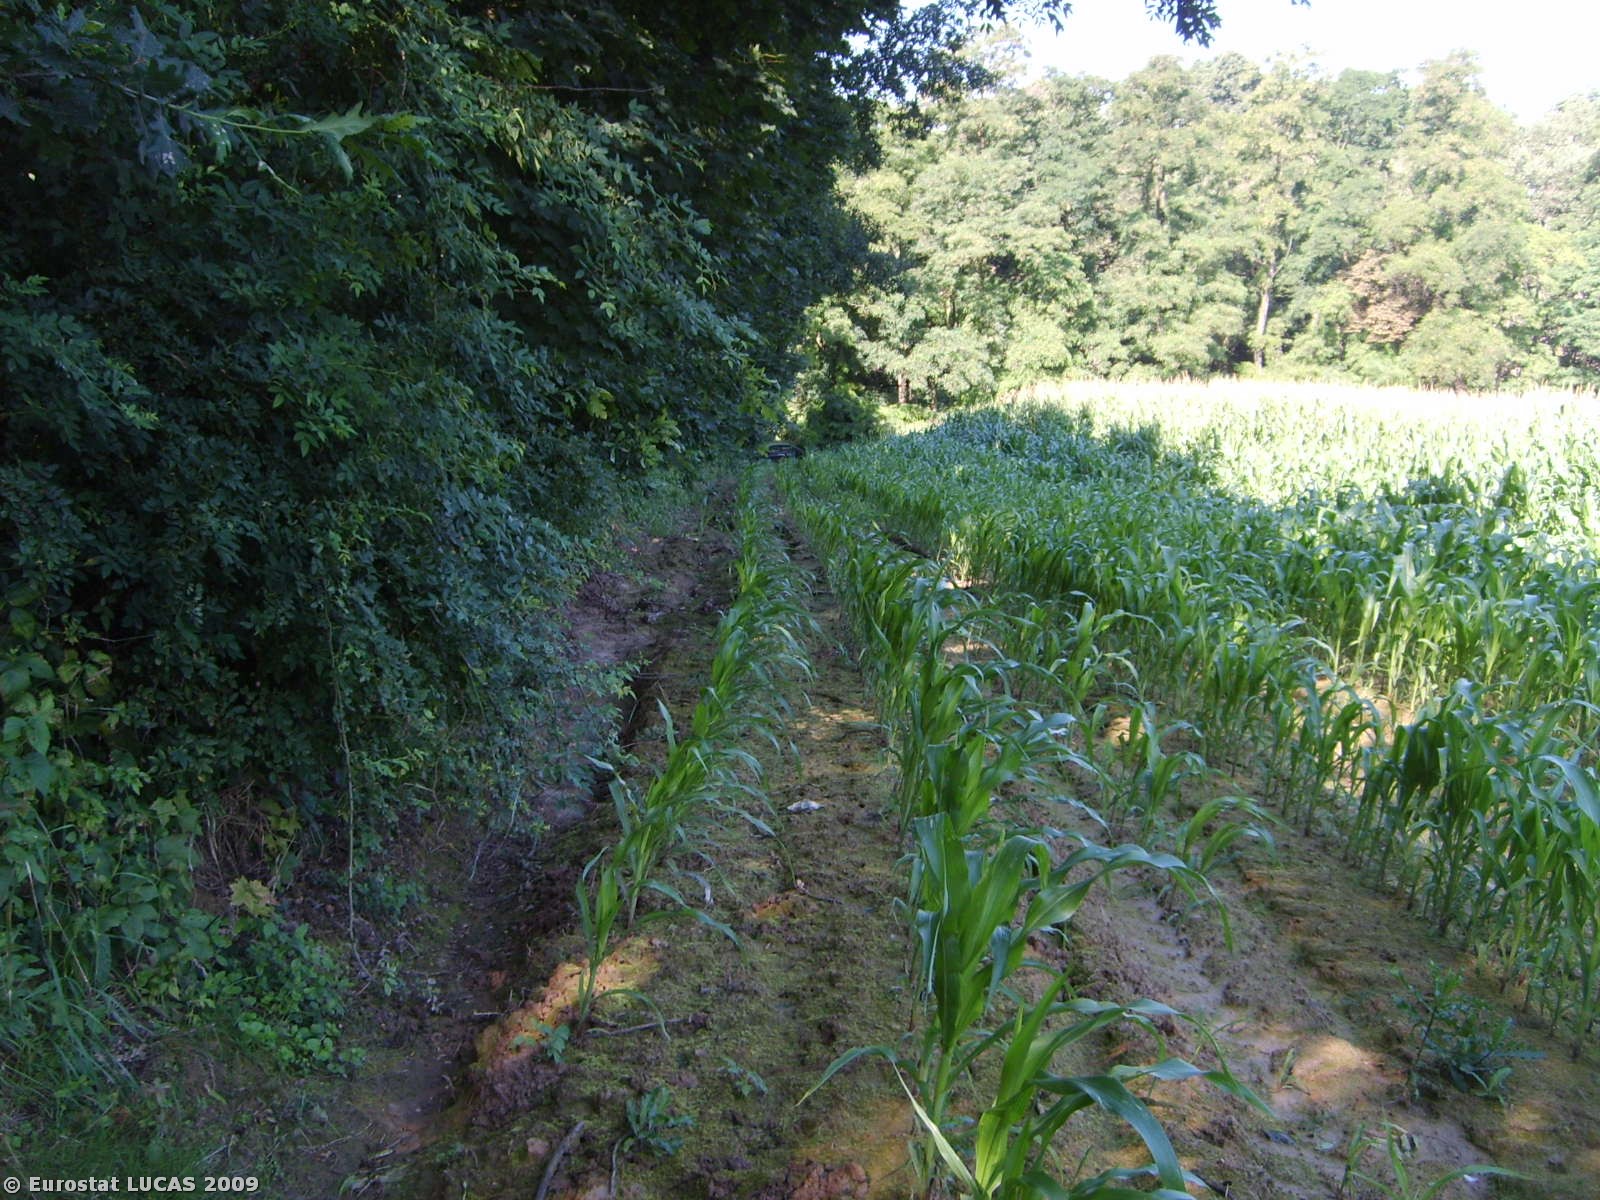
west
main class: Cropland
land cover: Maize
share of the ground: 50 - 75 %
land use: Agriculture (excluding fallow land and kitchen gardens)
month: July
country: PL
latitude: 50.1572
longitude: 20.2386
